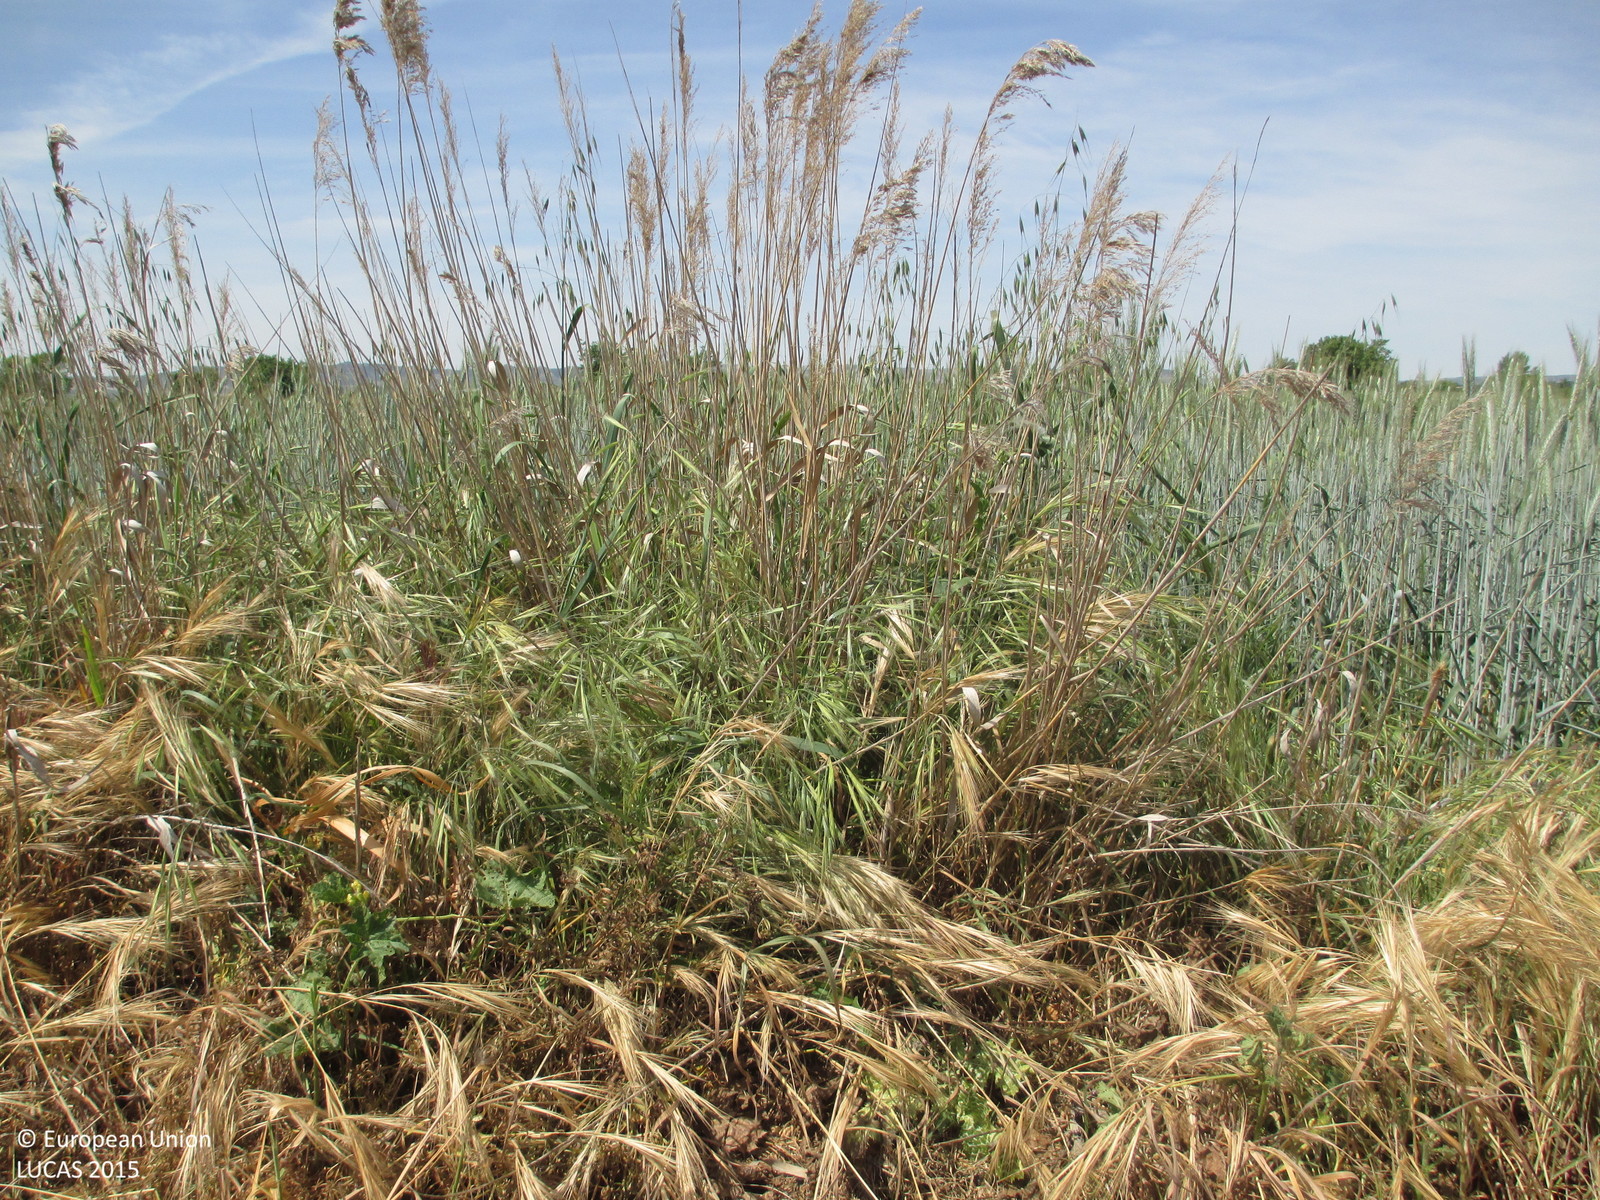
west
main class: Grassland
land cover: Spontaneously vegetated surfaces
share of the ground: > 75 %
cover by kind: herbaceous plants 100 %
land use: Agriculture (excluding fallow land and kitchen gardens)
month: May
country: ES
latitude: 41.8786
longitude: -0.4195
